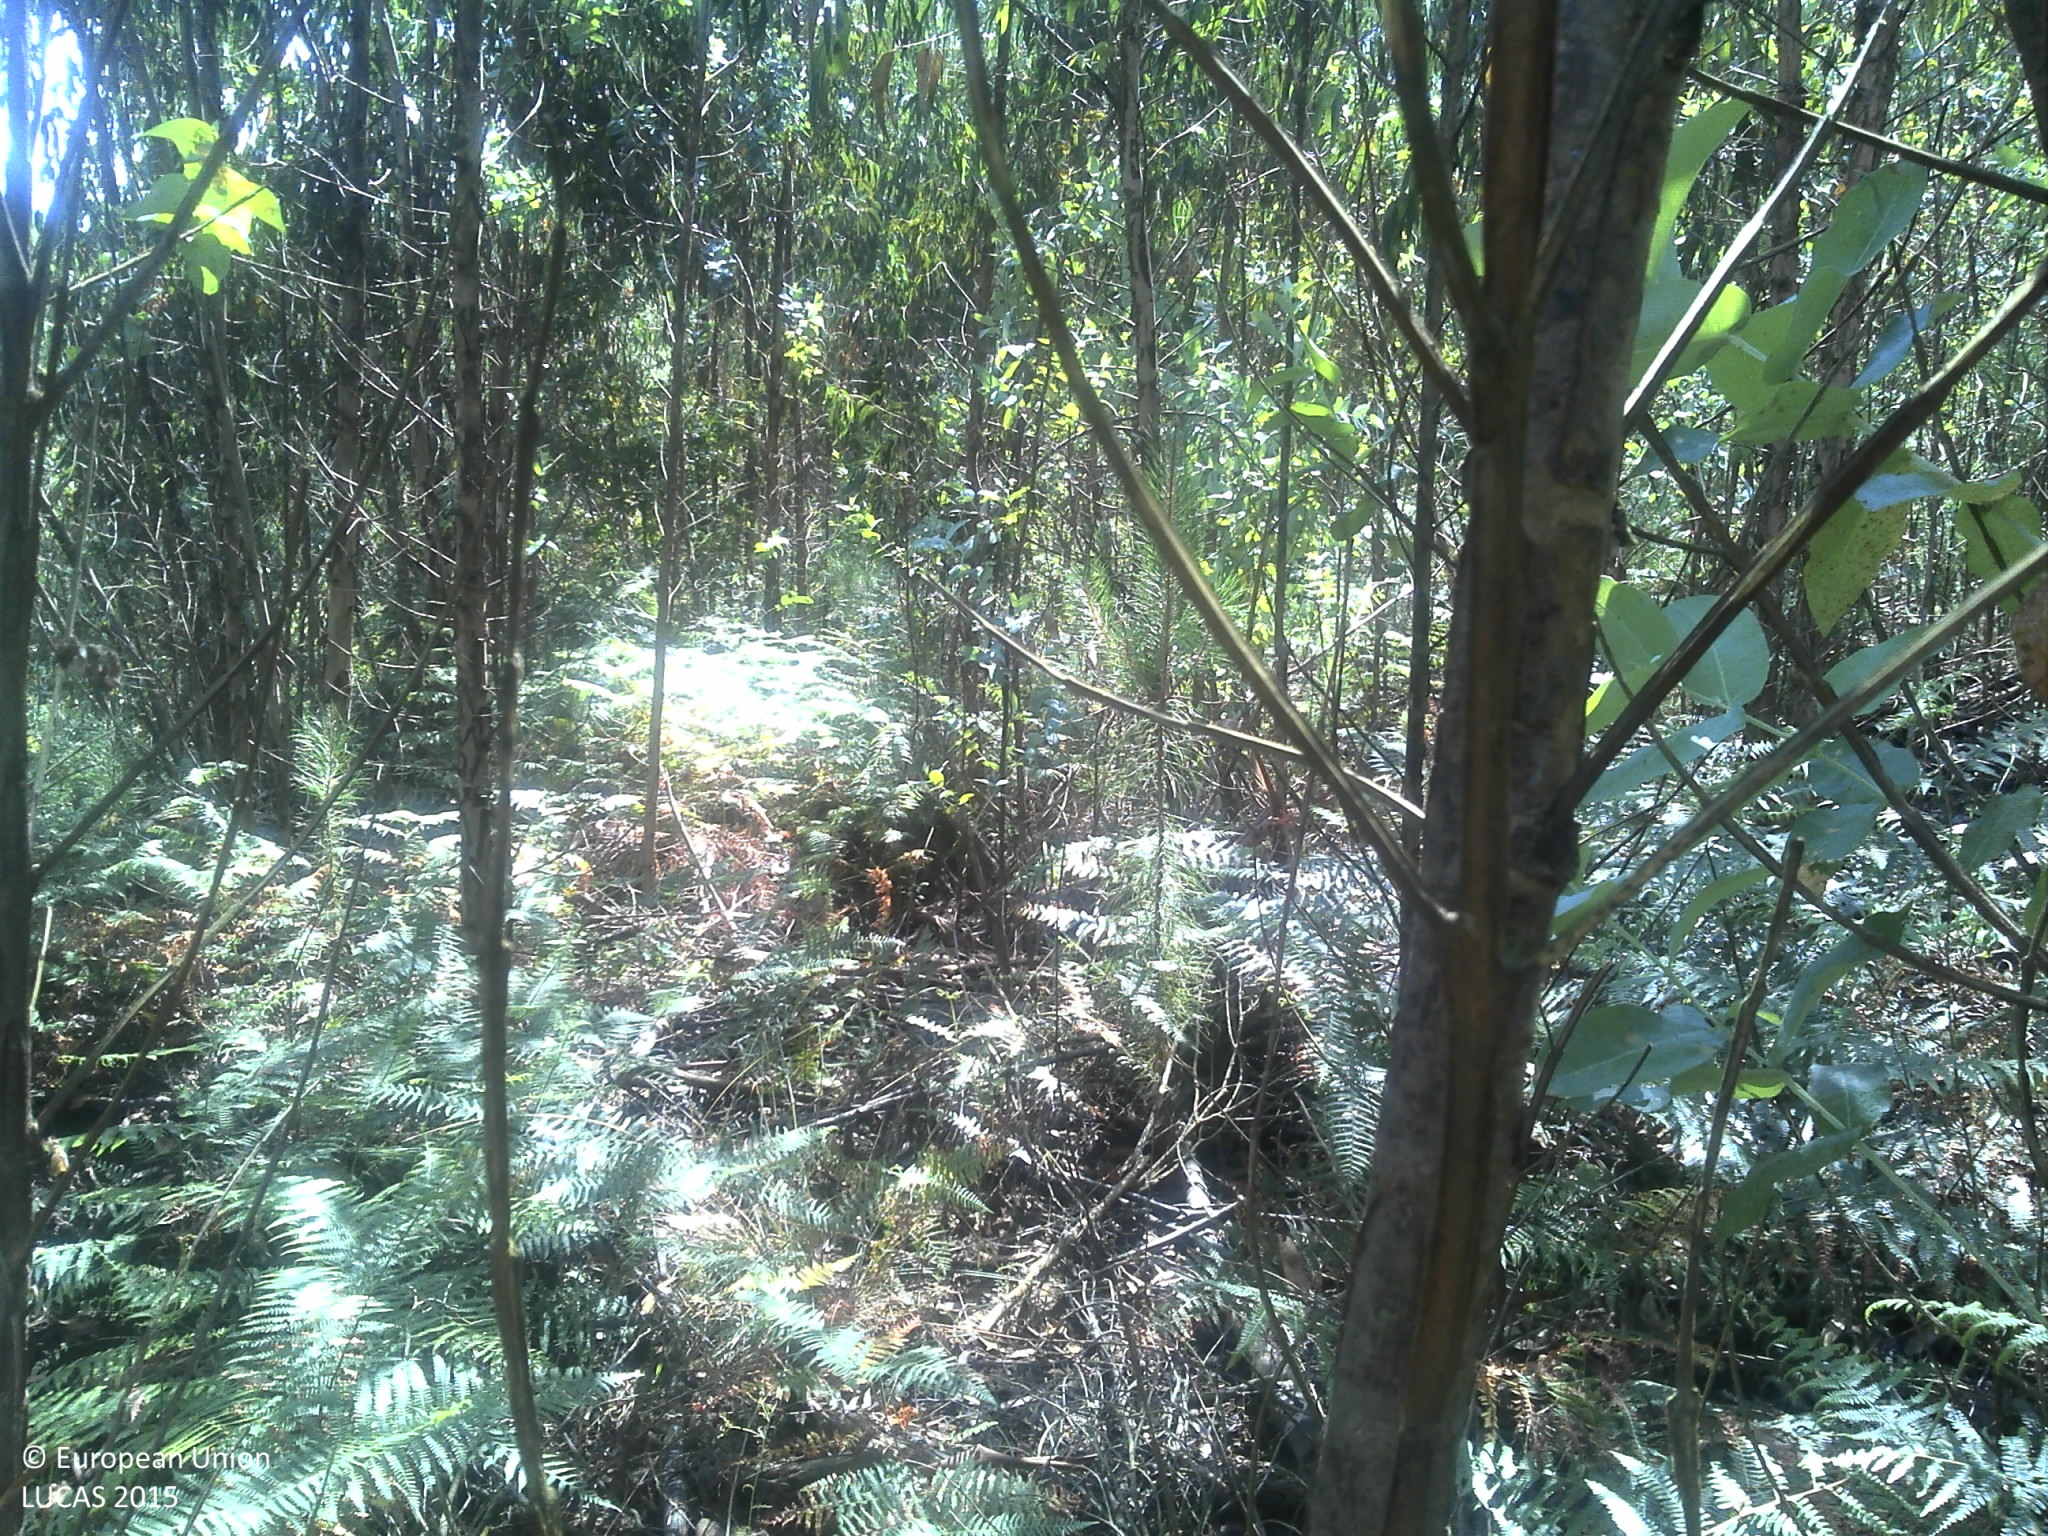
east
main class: Woodland
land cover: Broadleaved woodland
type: exotic forest
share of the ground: > 75 %
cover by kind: broadleaved forest trees 80 %, shrubs 15 %, unconsolidated bare surface 5 %
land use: Forestry
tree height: > 5 m
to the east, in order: Broadleaved woodland; Tracks; Broadleaved woodland; Tracks; Grassland without tree/shrub cover
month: June
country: PT
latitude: 41.6057
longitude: -8.6520
